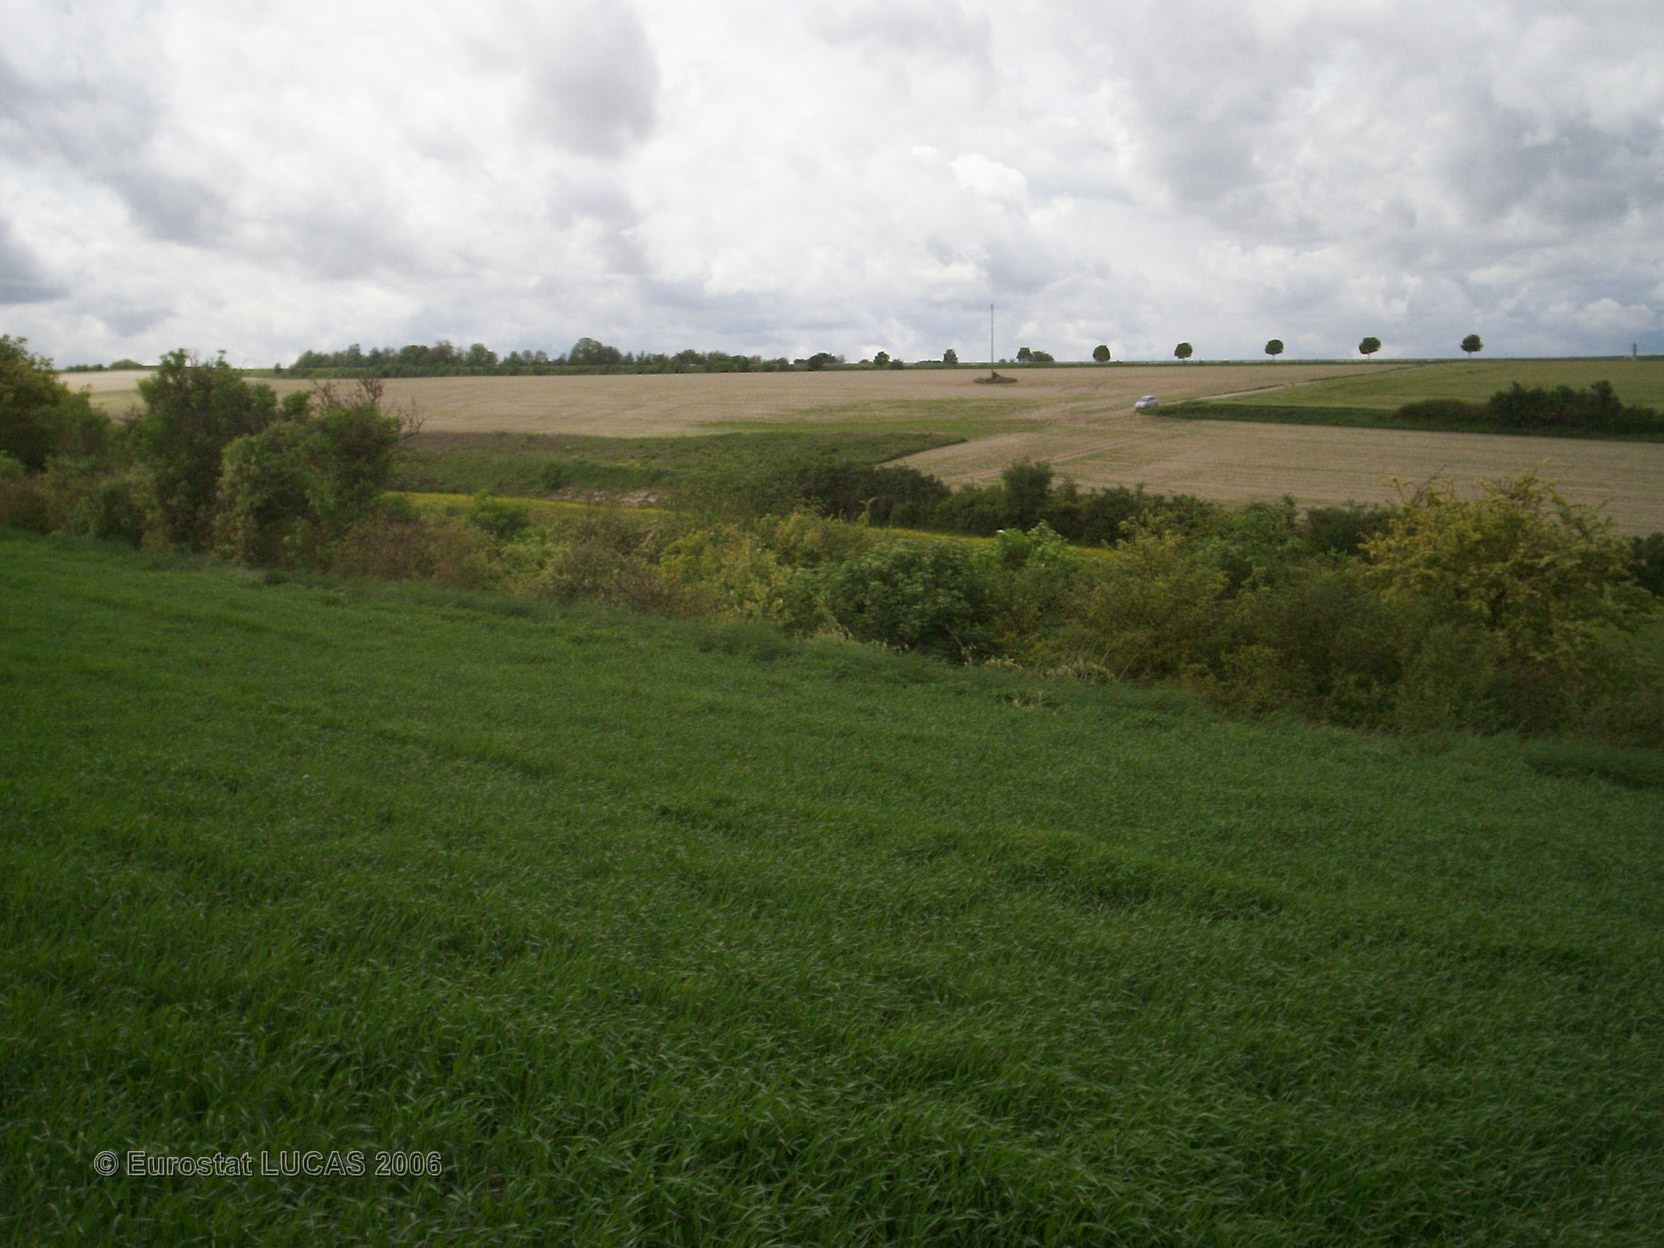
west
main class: Cropland
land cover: Barley
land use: Agriculture (excluding fallow land and kitchen gardens)
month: May
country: FR
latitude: 49.4853
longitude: 4.3501
